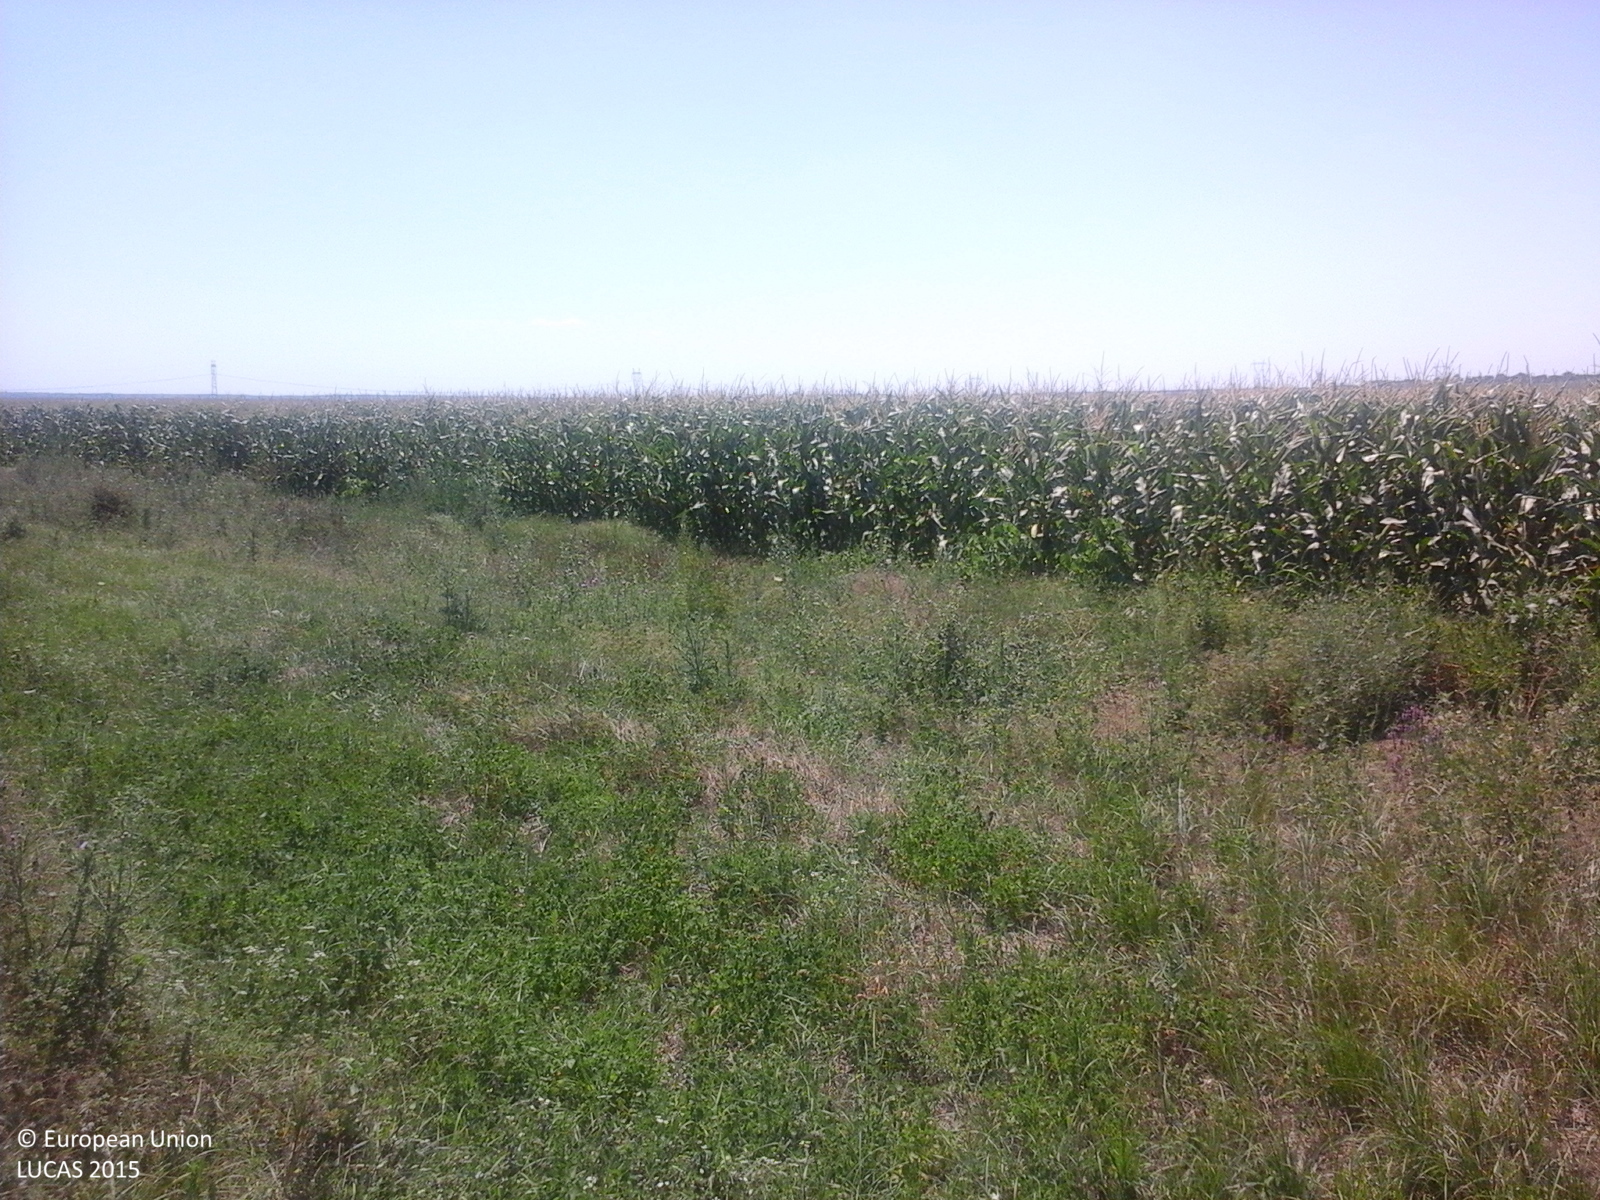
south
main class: Grassland
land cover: Grassland with sparse tree/shrub cover
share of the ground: > 75 %
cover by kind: herbaceous plants 85 %, shrubs 10 %, broadleaved forest trees 5 %
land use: Agriculture (excluding fallow land and kitchen gardens)
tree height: > 5 m
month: July
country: RO
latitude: 44.2608
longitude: 26.4327
